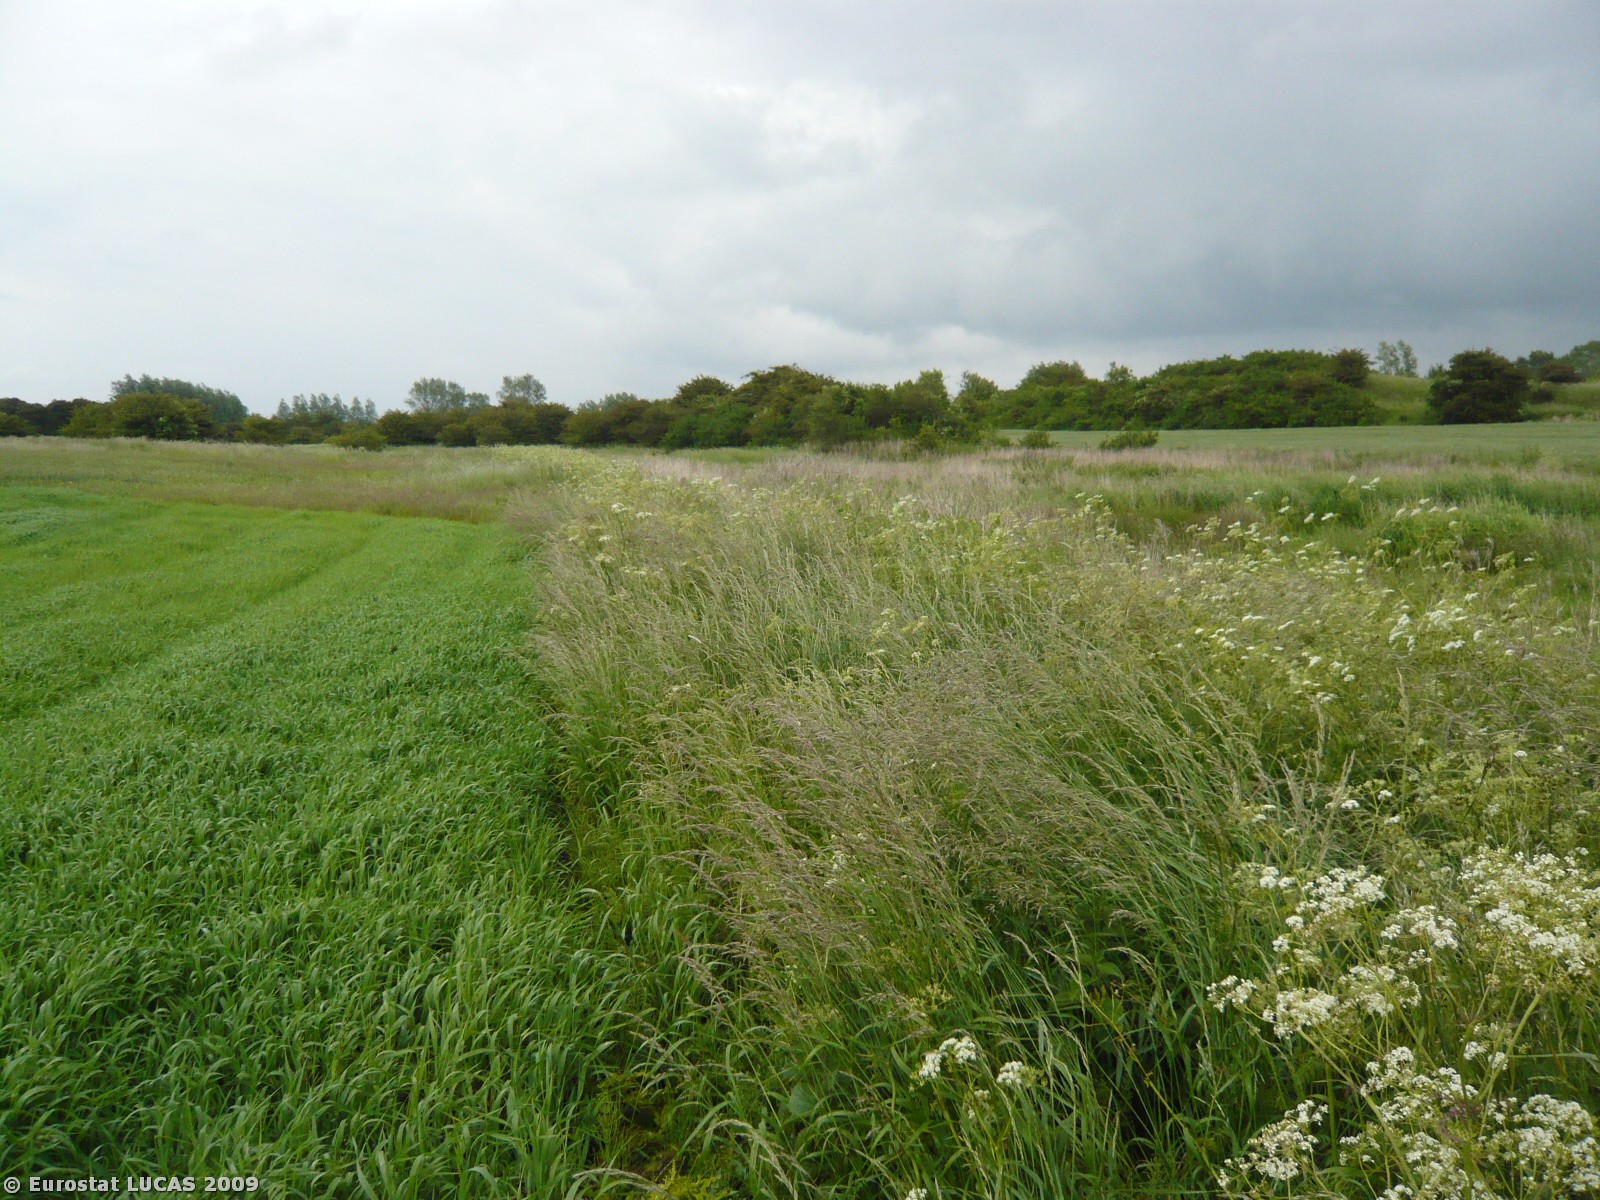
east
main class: Cropland
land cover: Barley
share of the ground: > 75 %
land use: Agriculture (excluding fallow land and kitchen gardens)
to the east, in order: Barley; Grassland without tree/shrub cover; Tracks; Grassland without tree/shrub cover; Shrubland with sparse tree cover; Common wheat; Broadleaved woodland; Grass margins; Tracks; Grass margins; Broadleaved woodland; Fences; Shrubland with sparse tree cover
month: June
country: DK
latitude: 54.9149
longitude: 11.9175
